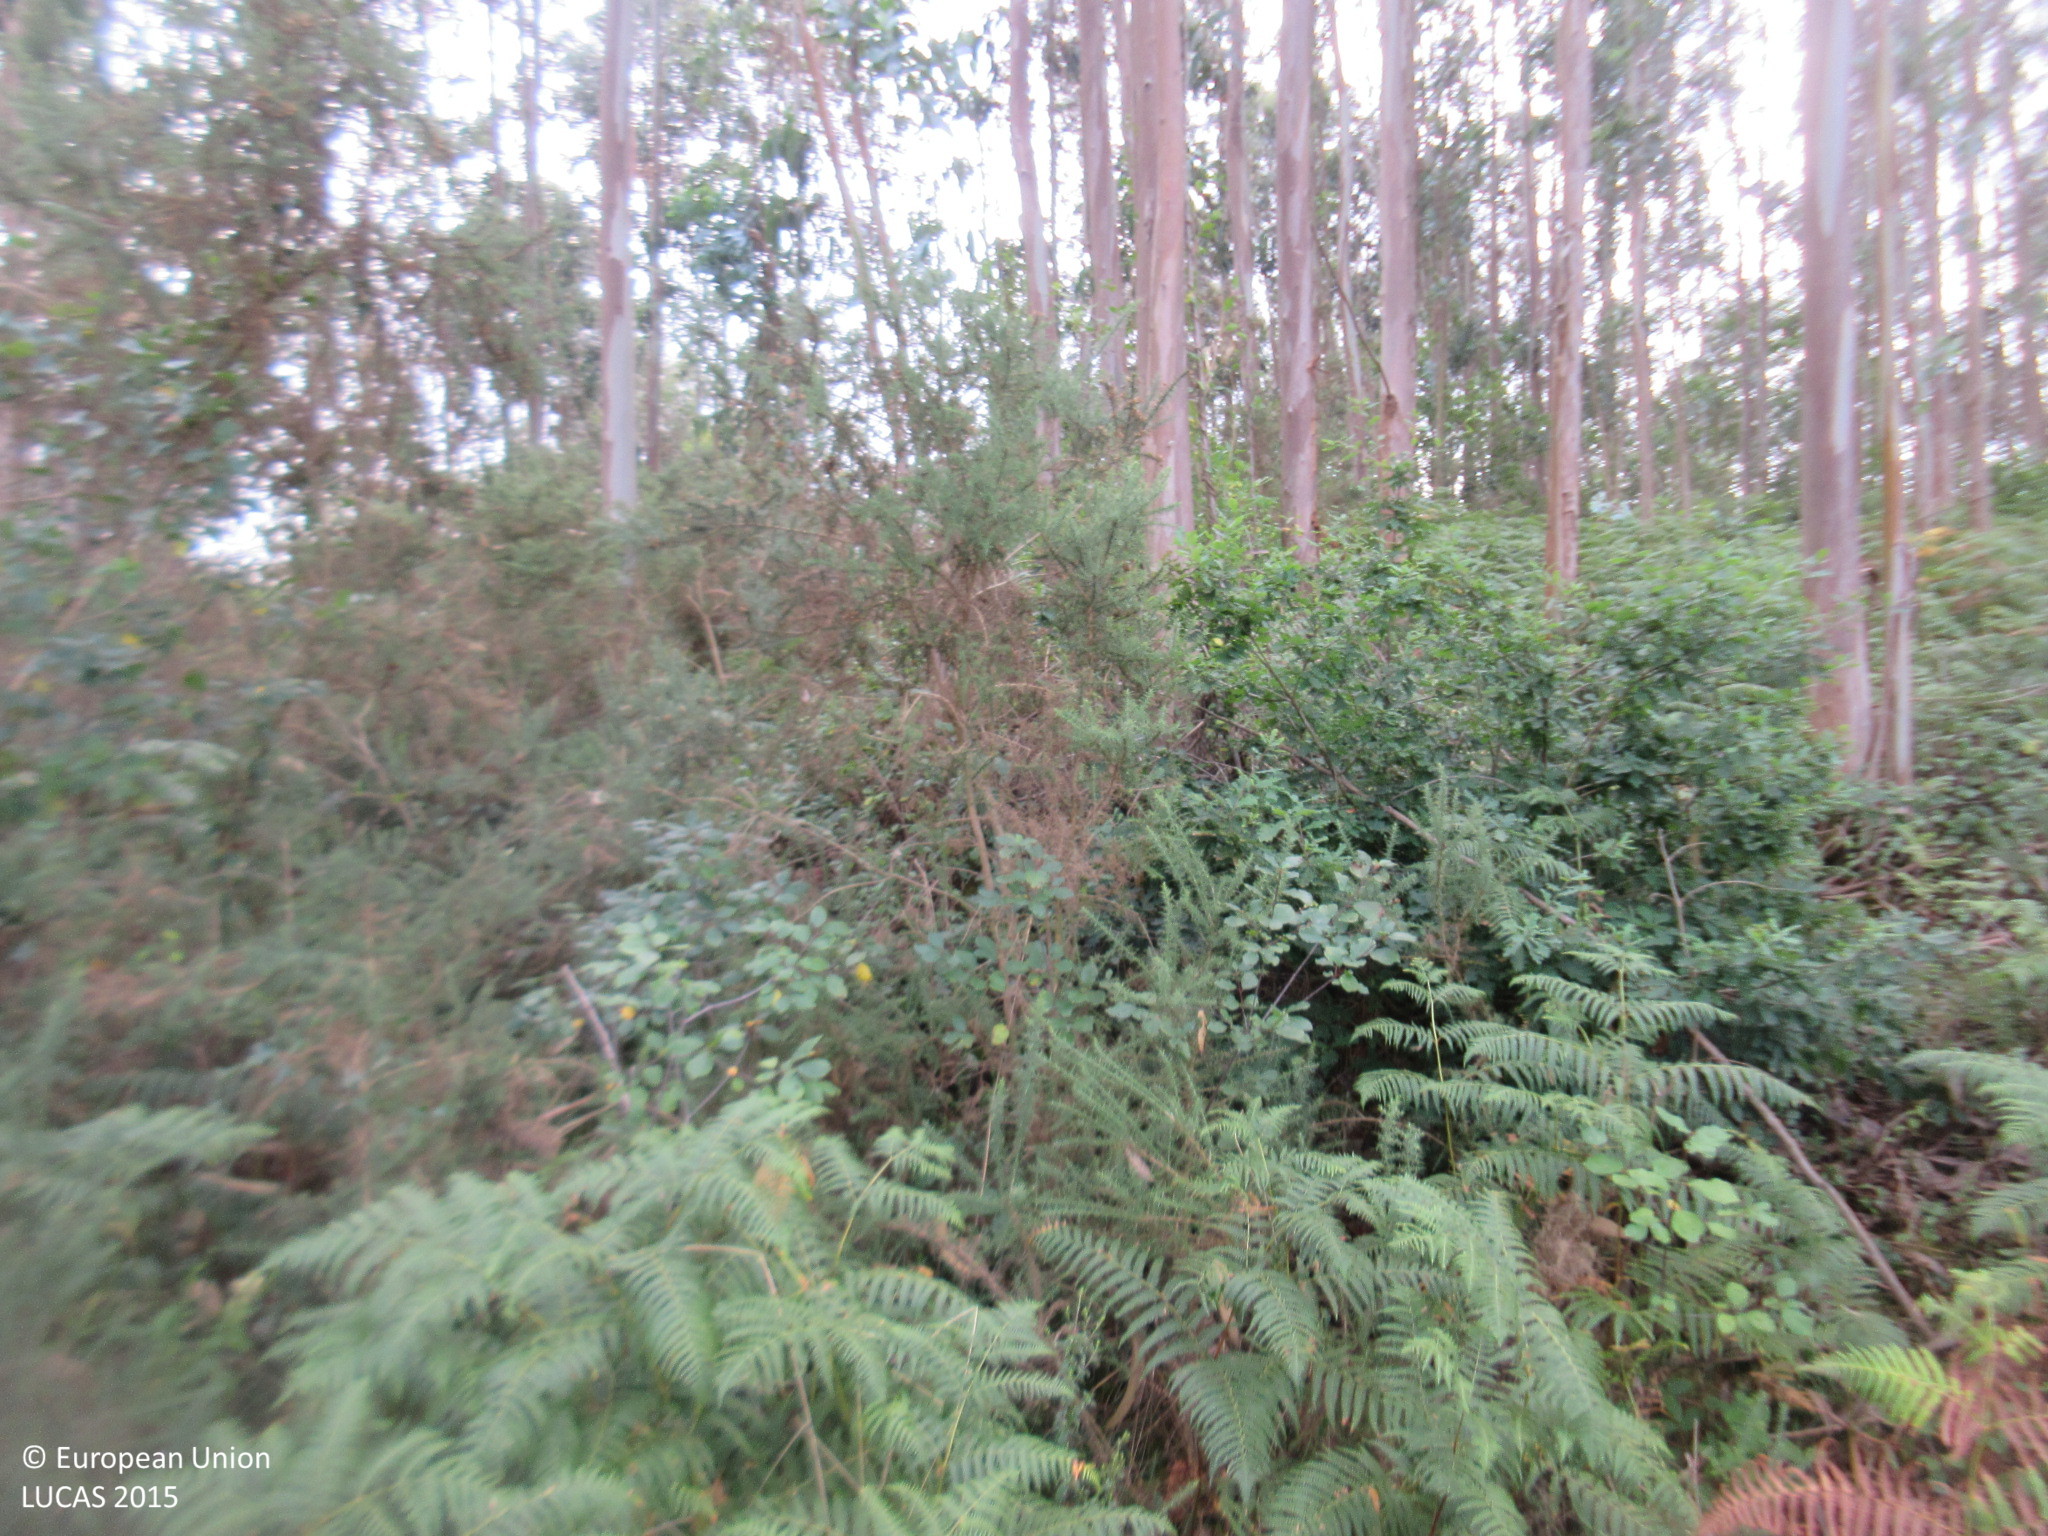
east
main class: Woodland
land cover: Broadleaved woodland
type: exotic forest
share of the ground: > 75 %
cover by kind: broadleaved forest trees 95 %, shrubs 5 %
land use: Forestry
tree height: > 5 m
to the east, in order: Broadleaved woodland; Grassland without tree/shrub cover
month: July
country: ES
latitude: 43.3829
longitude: -3.9623
